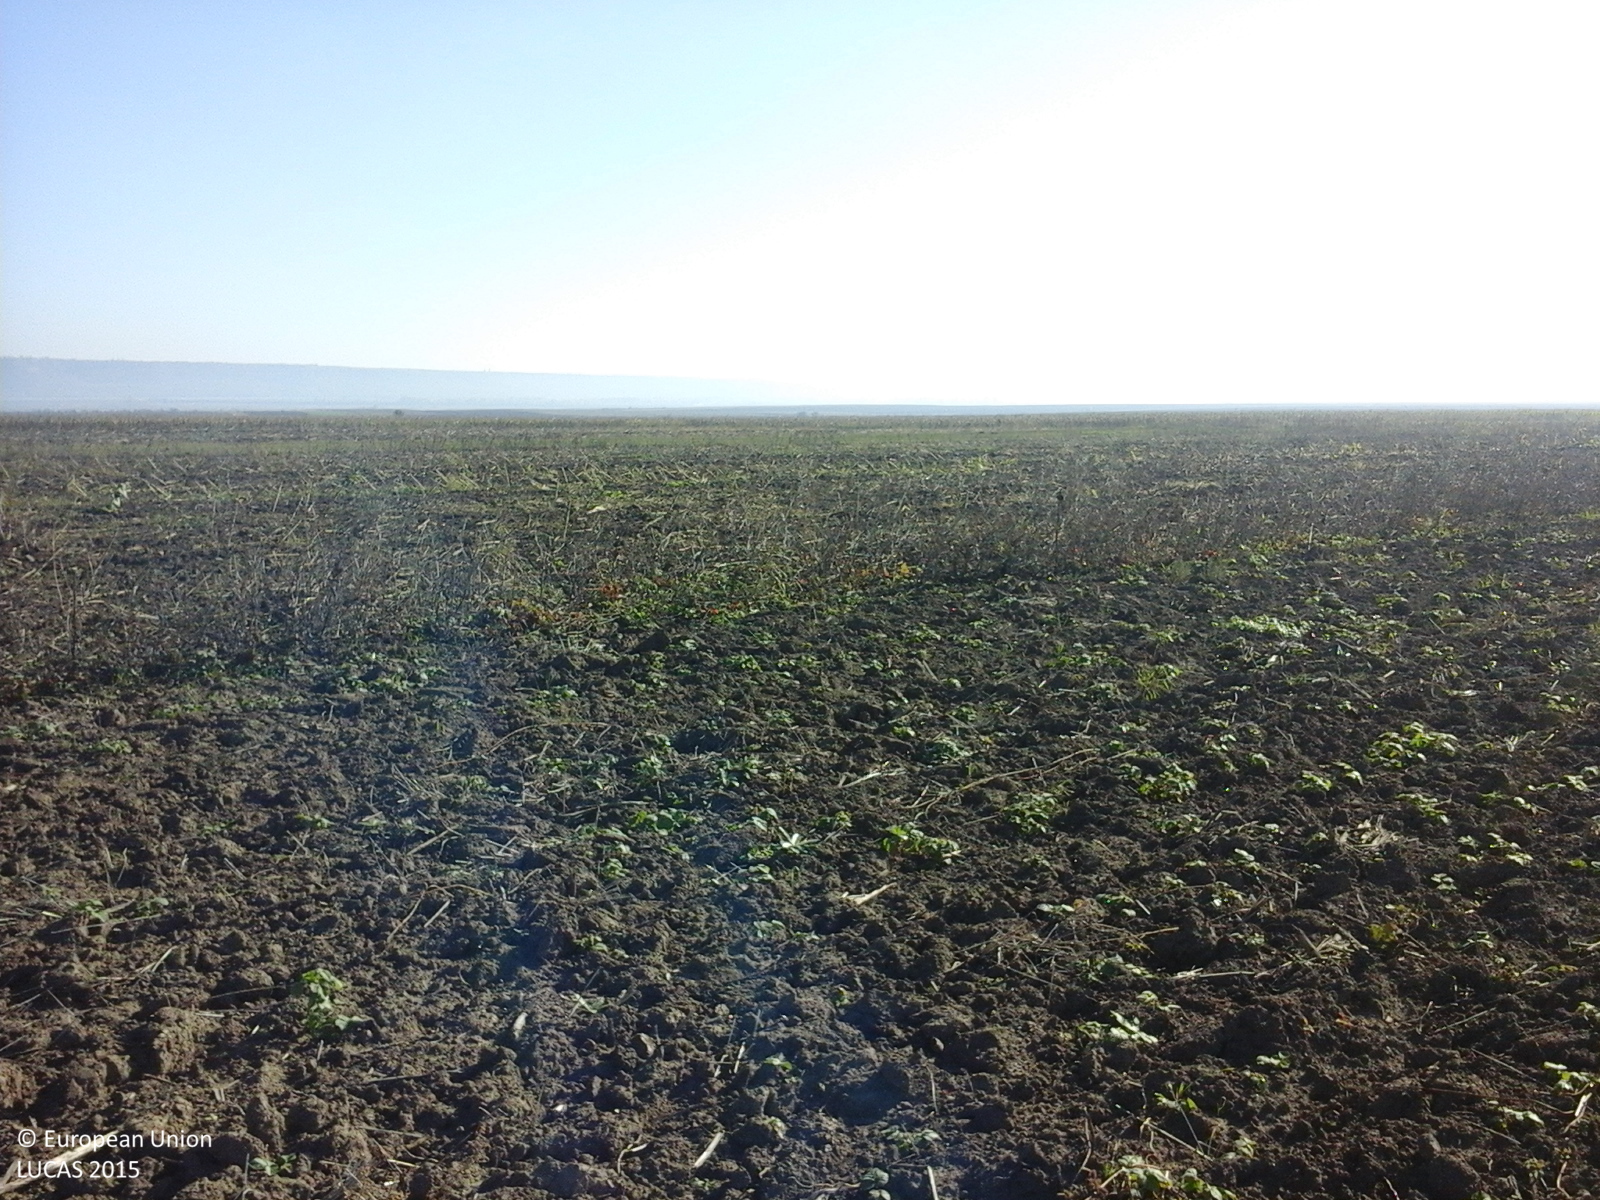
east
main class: Cropland
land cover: Common wheat
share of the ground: < 10 %
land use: Agriculture (excluding fallow land and kitchen gardens)
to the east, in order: Common wheat; Maize; Lucerne; Sunflower; Maize; Spontaneously vegetated surfaces; Maize
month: October
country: RO
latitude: 45.9442
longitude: 27.1622
